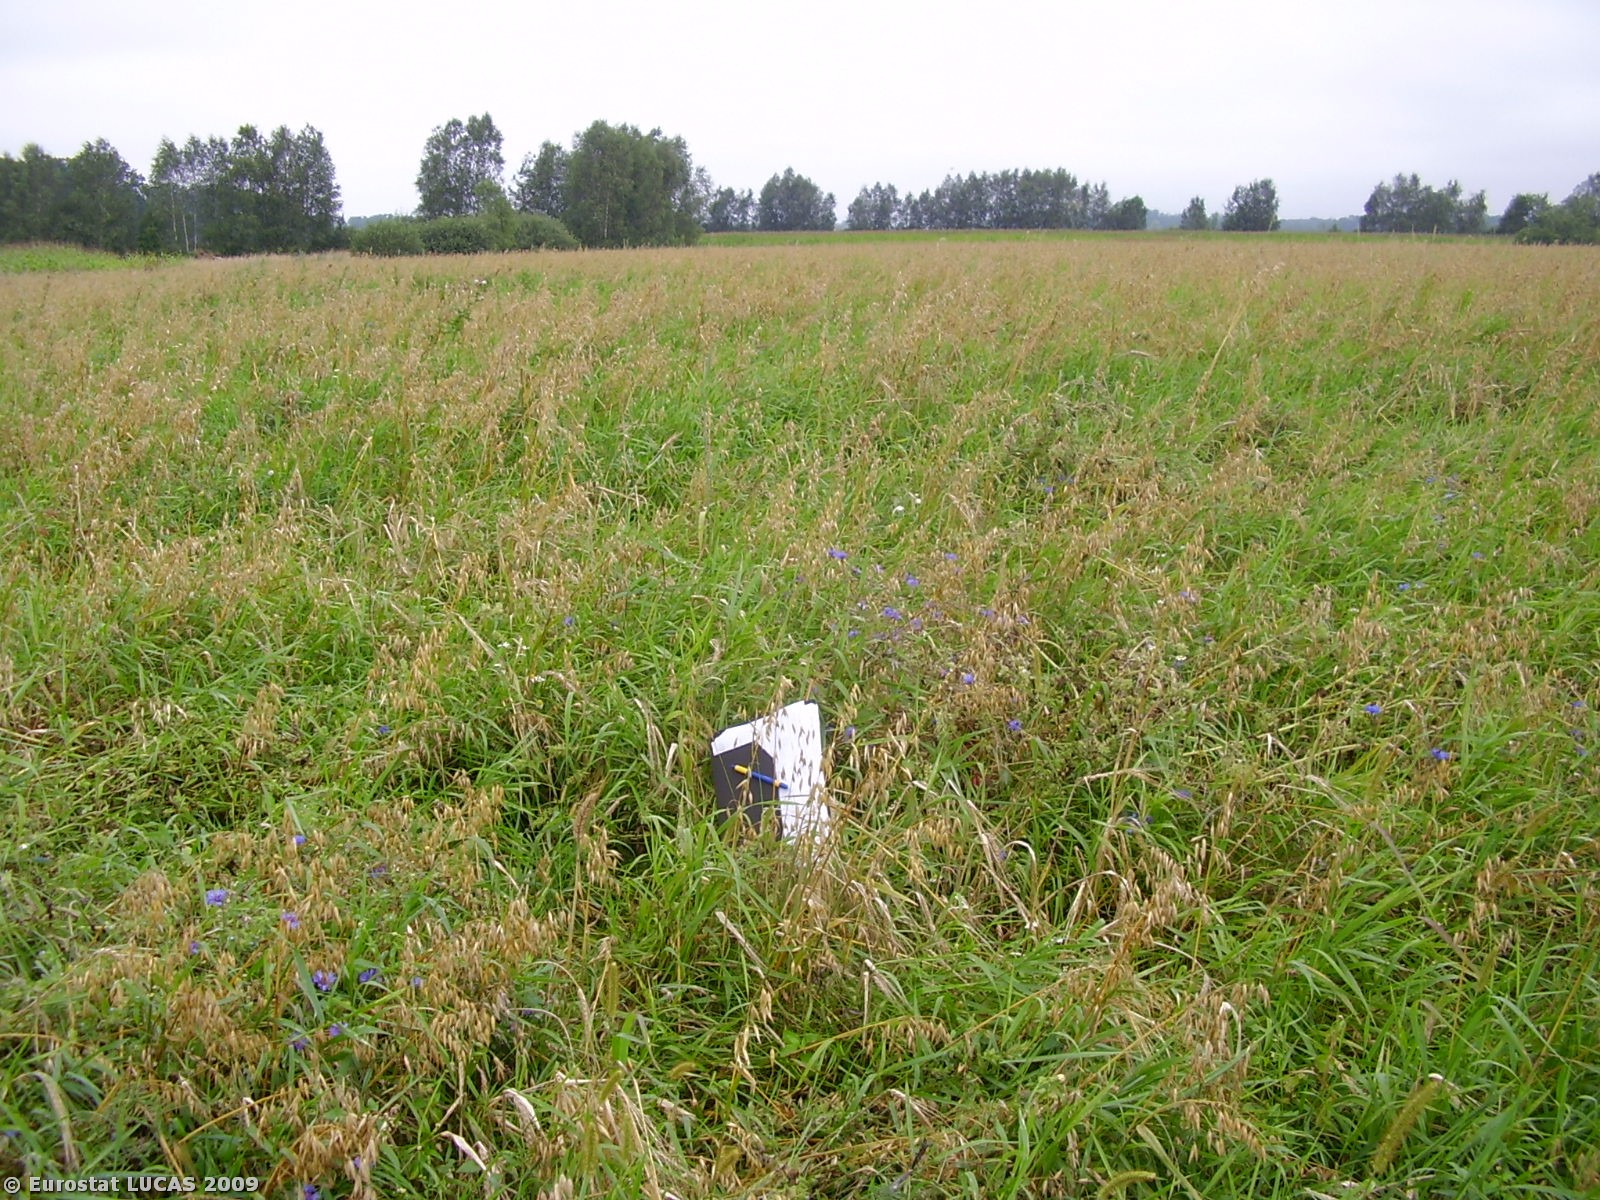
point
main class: Grassland
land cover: Spontaneously vegetated surfaces
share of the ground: > 75 %
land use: Fallow land
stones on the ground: < 10 %
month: April
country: PL
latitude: 51.5314
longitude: 16.8278
